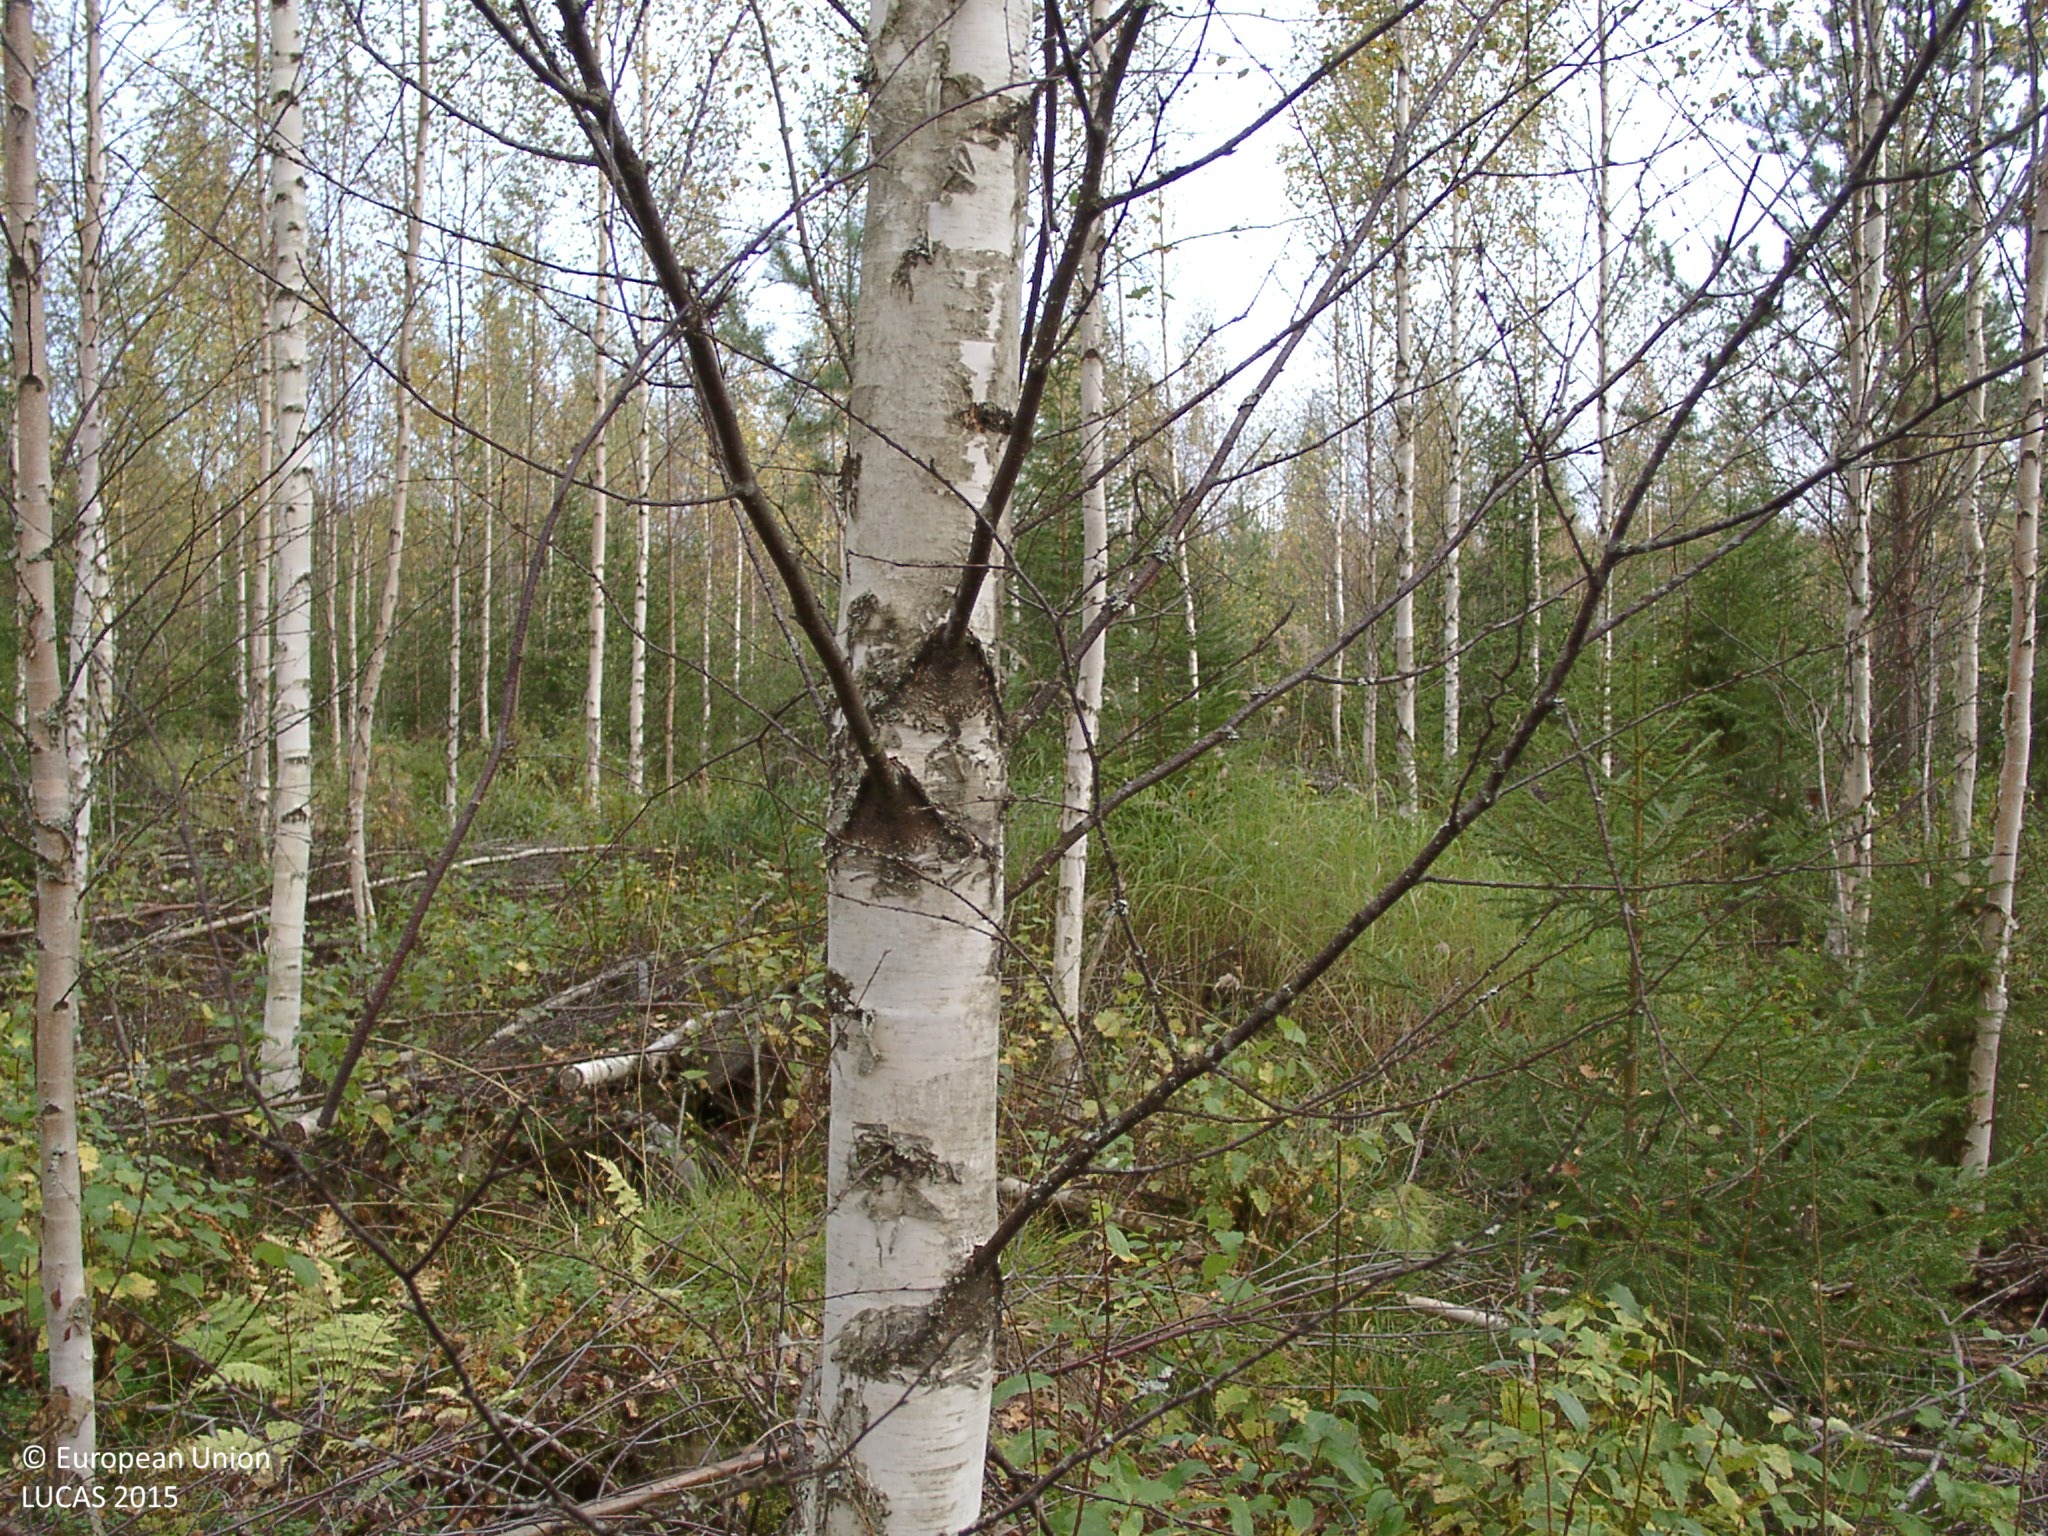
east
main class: Woodland
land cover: Spruce dominated mixed woodland
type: boreal forest
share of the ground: 50 - 75 %
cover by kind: broadleaved forest trees 60 %, coniferous forest trees 20 %, unconsolidated bare surface 10 %, shrubs 5 %, herbaceous plants 5 %
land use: Forestry
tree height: > 5 m
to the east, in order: Spruce dominated mixed woodland; Ditches and canals; Other mixed woodland; Ditches and canals; Other mixed woodland; Pine dominated mixed woodland; Spruce dominated mixed woodland; Electric lines; Broadleaved woodland; Spruce dominated coniferous woodland; Other mixed woodland
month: September
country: FI
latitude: 62.6623
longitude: 25.3907
